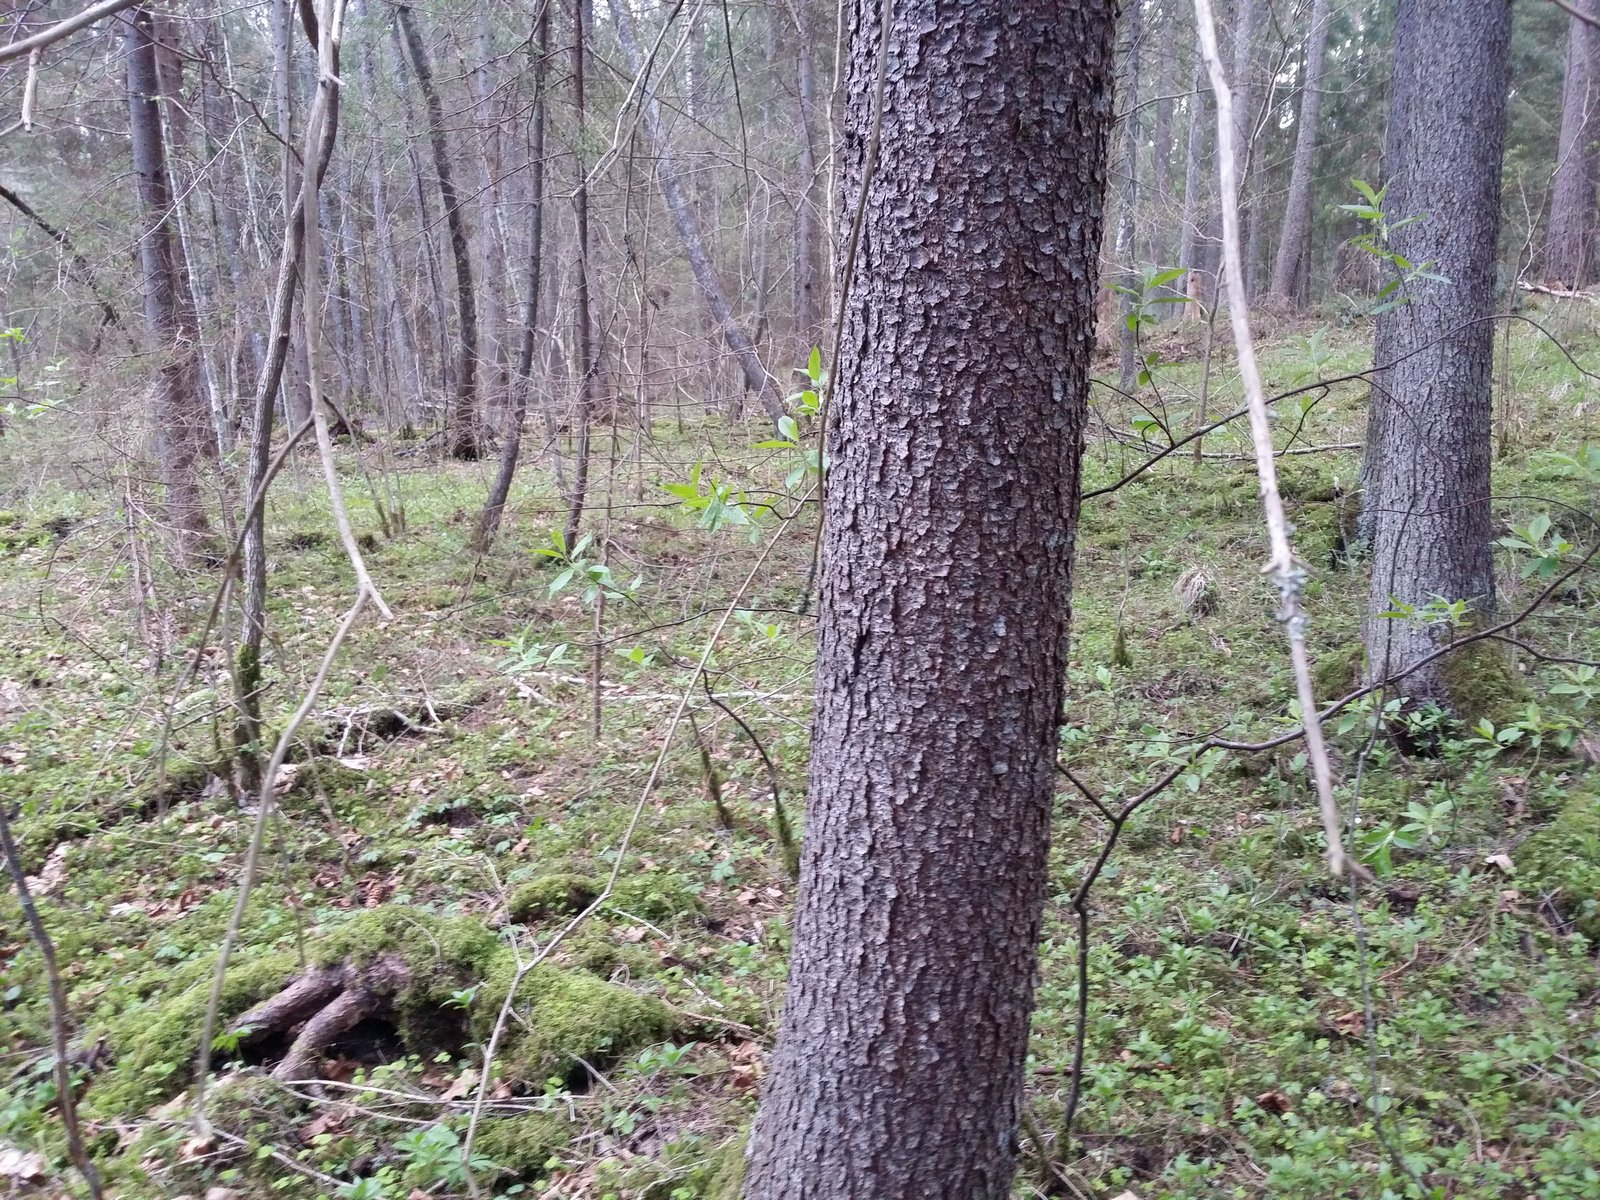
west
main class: Woodland
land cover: Spruce dominated mixed woodland
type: hemiboreal forest and nemoral coniferous forest and mixed broadleaved-coniferous forest
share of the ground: > 75 %
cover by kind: coniferous forest trees 65 %, broadleaved forest trees 25 %, lichens and mosses 10 %
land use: Forestry
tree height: > 5 m
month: May
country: LV
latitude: 57.3785
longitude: 26.0129
